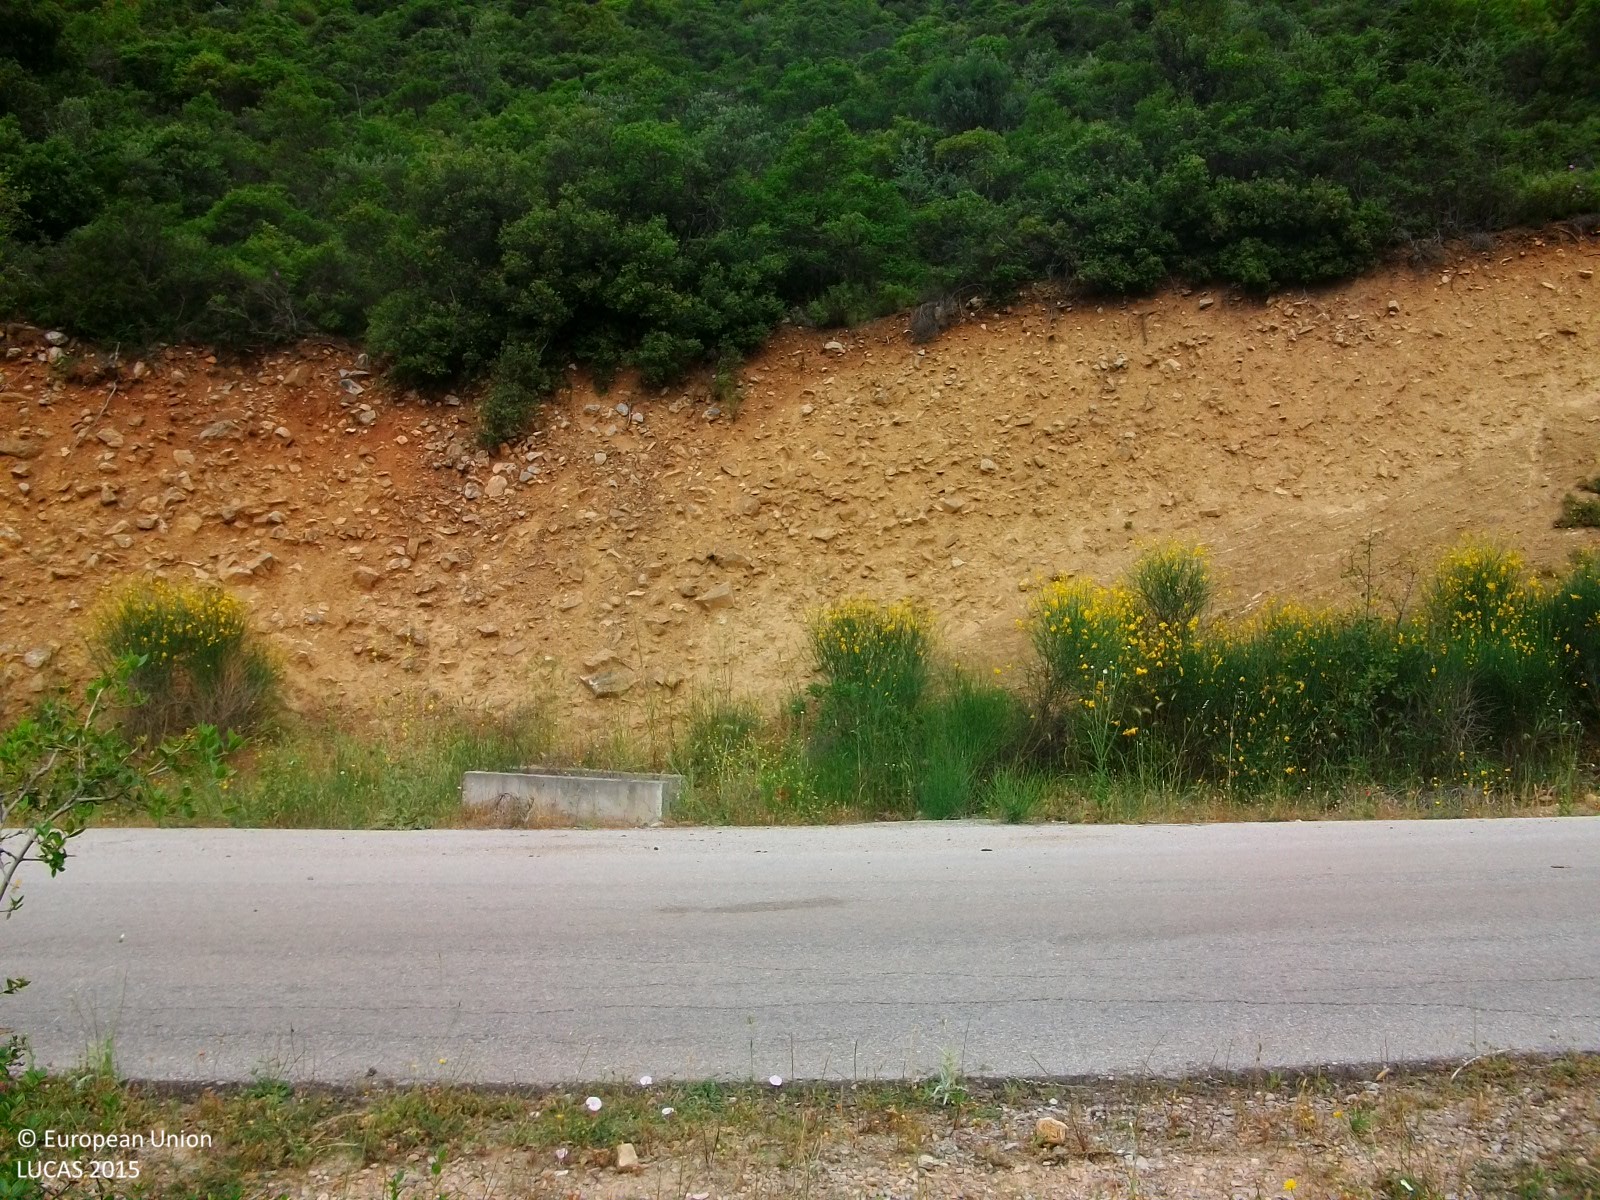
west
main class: Shrubland
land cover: Shrubland with sparse tree cover
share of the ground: > 75 %
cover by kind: shrubs 95 %, broadleaved forest trees 5 %
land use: Semi-natural and natural areas not in use
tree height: < 5 m
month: May
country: GR
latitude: 38.9402
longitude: 22.5925
